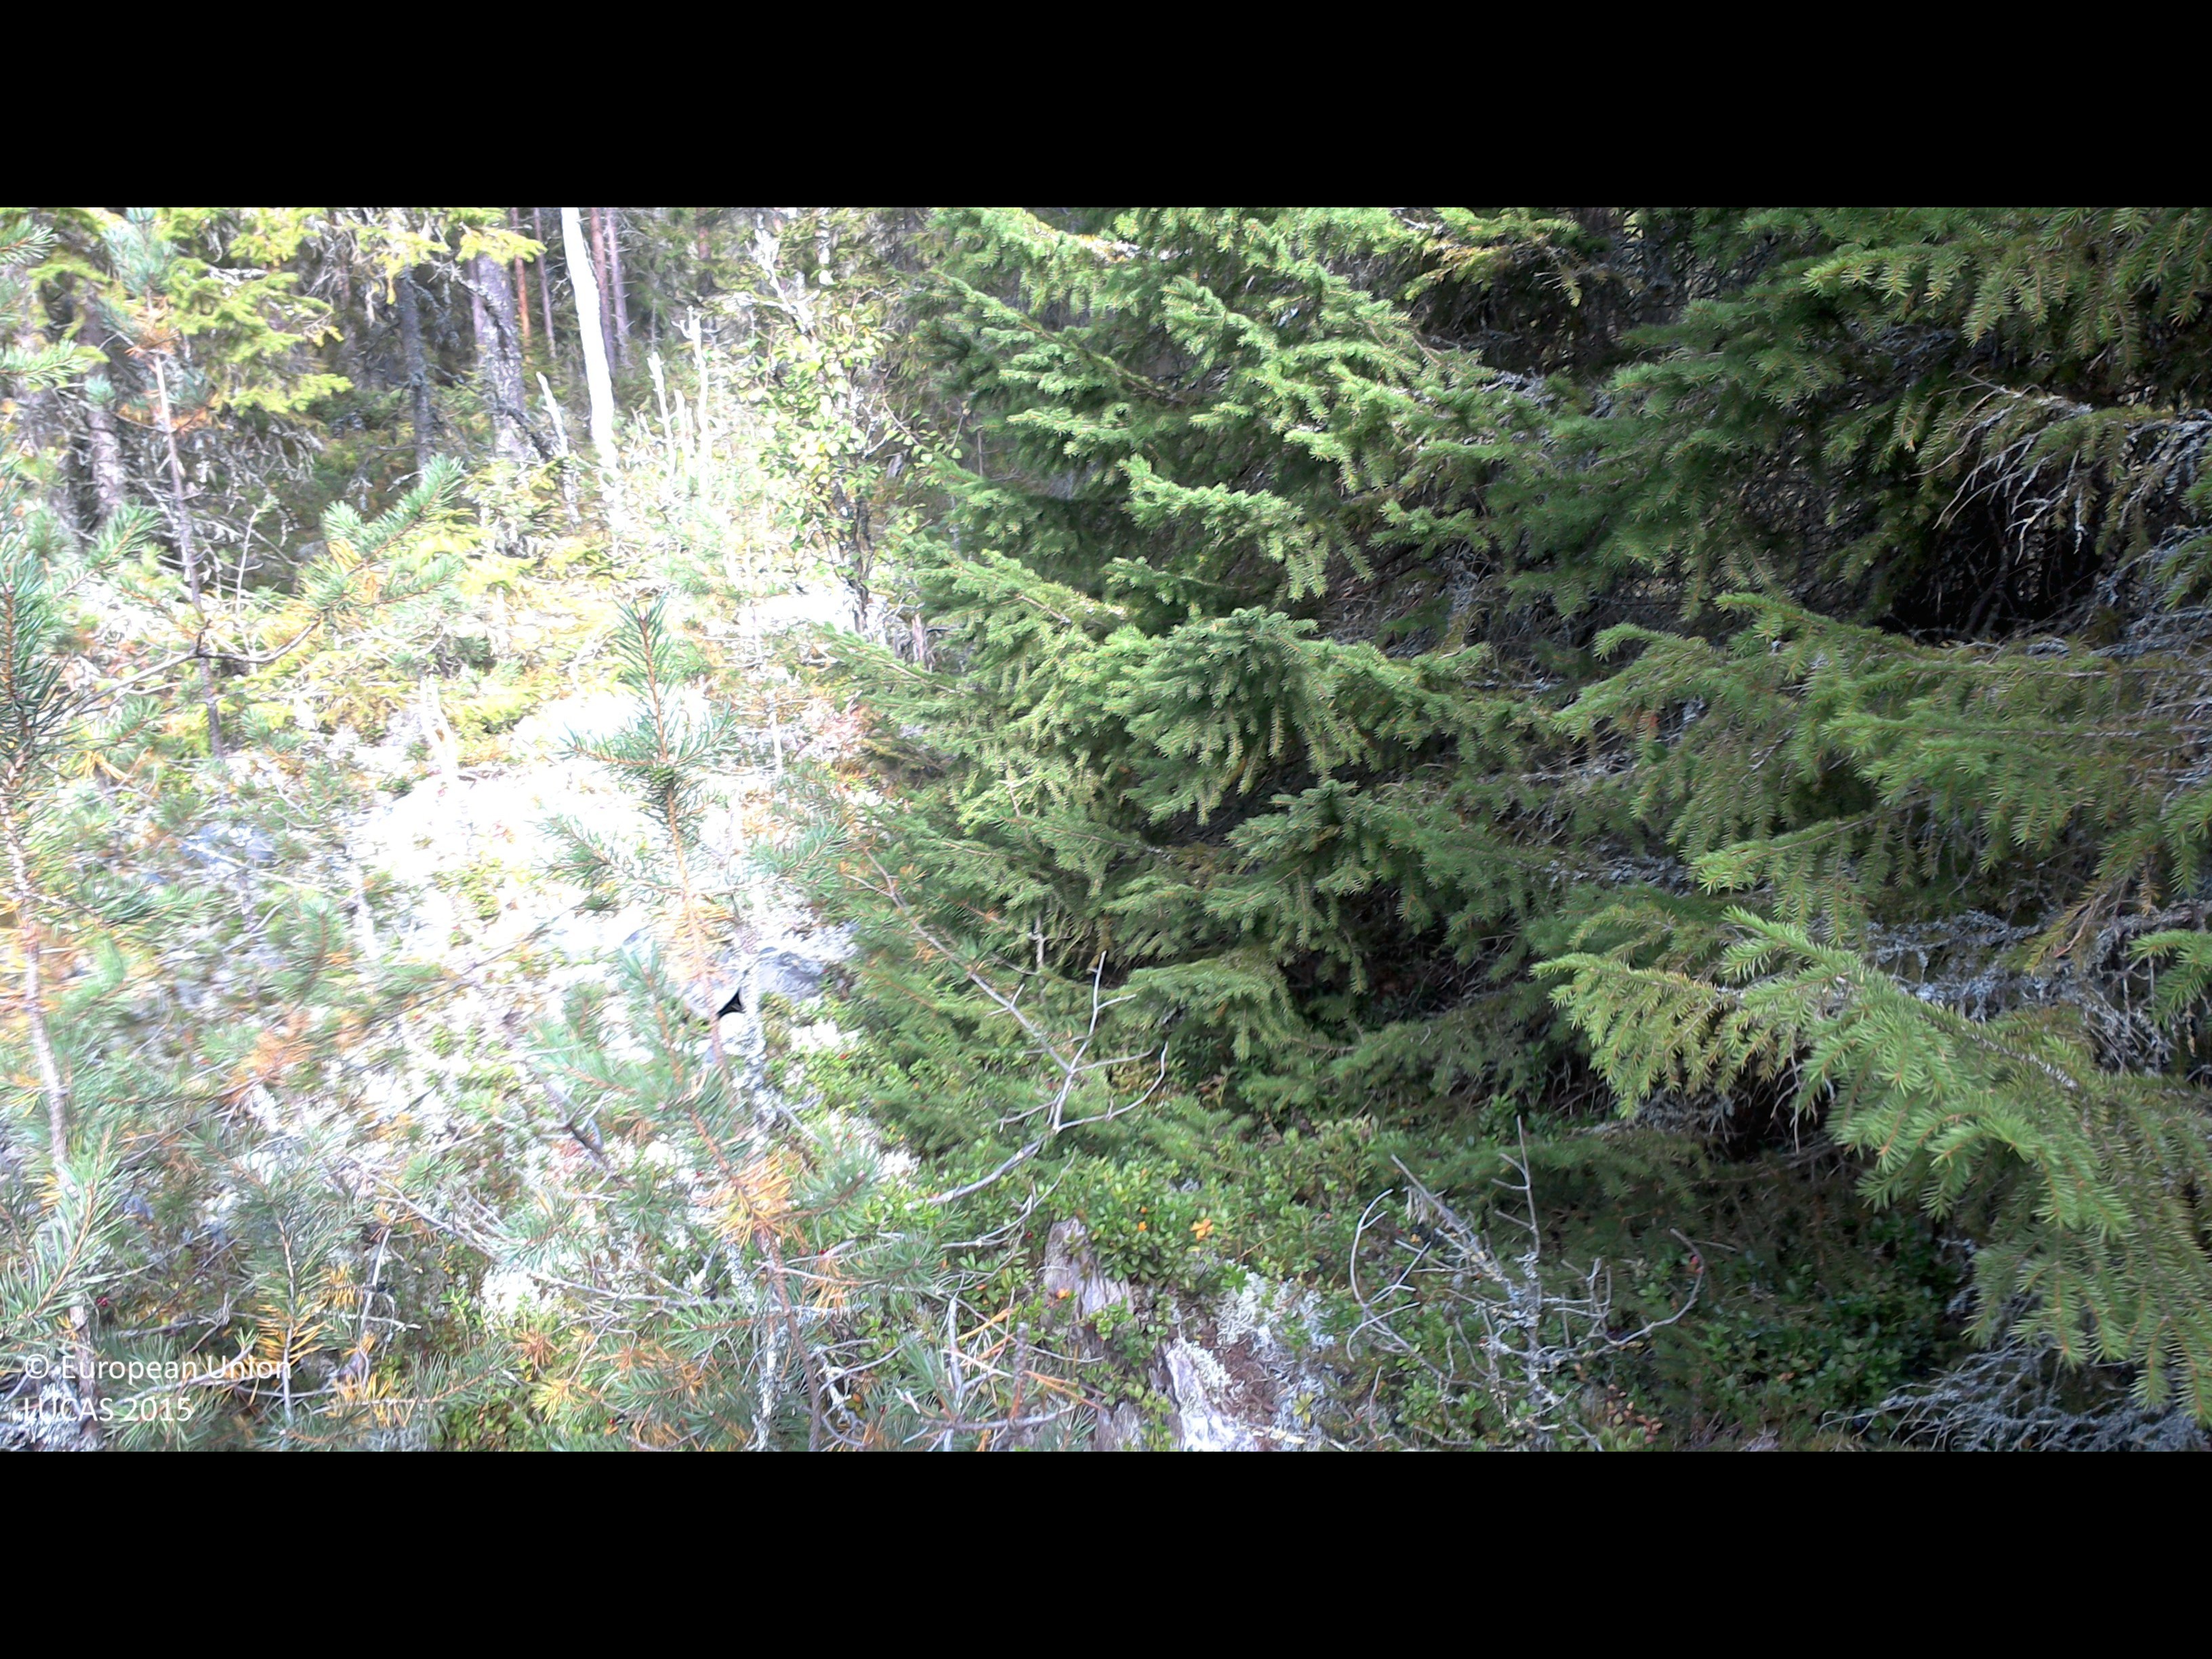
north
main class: Woodland
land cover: Other coniferous woodland
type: boreal forest
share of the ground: 25 - 50 %
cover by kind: coniferous forest trees 50 %, shrubs 50 %
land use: Forestry
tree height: > 5 m
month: September
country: SE
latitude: 63.5874
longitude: 19.7532
